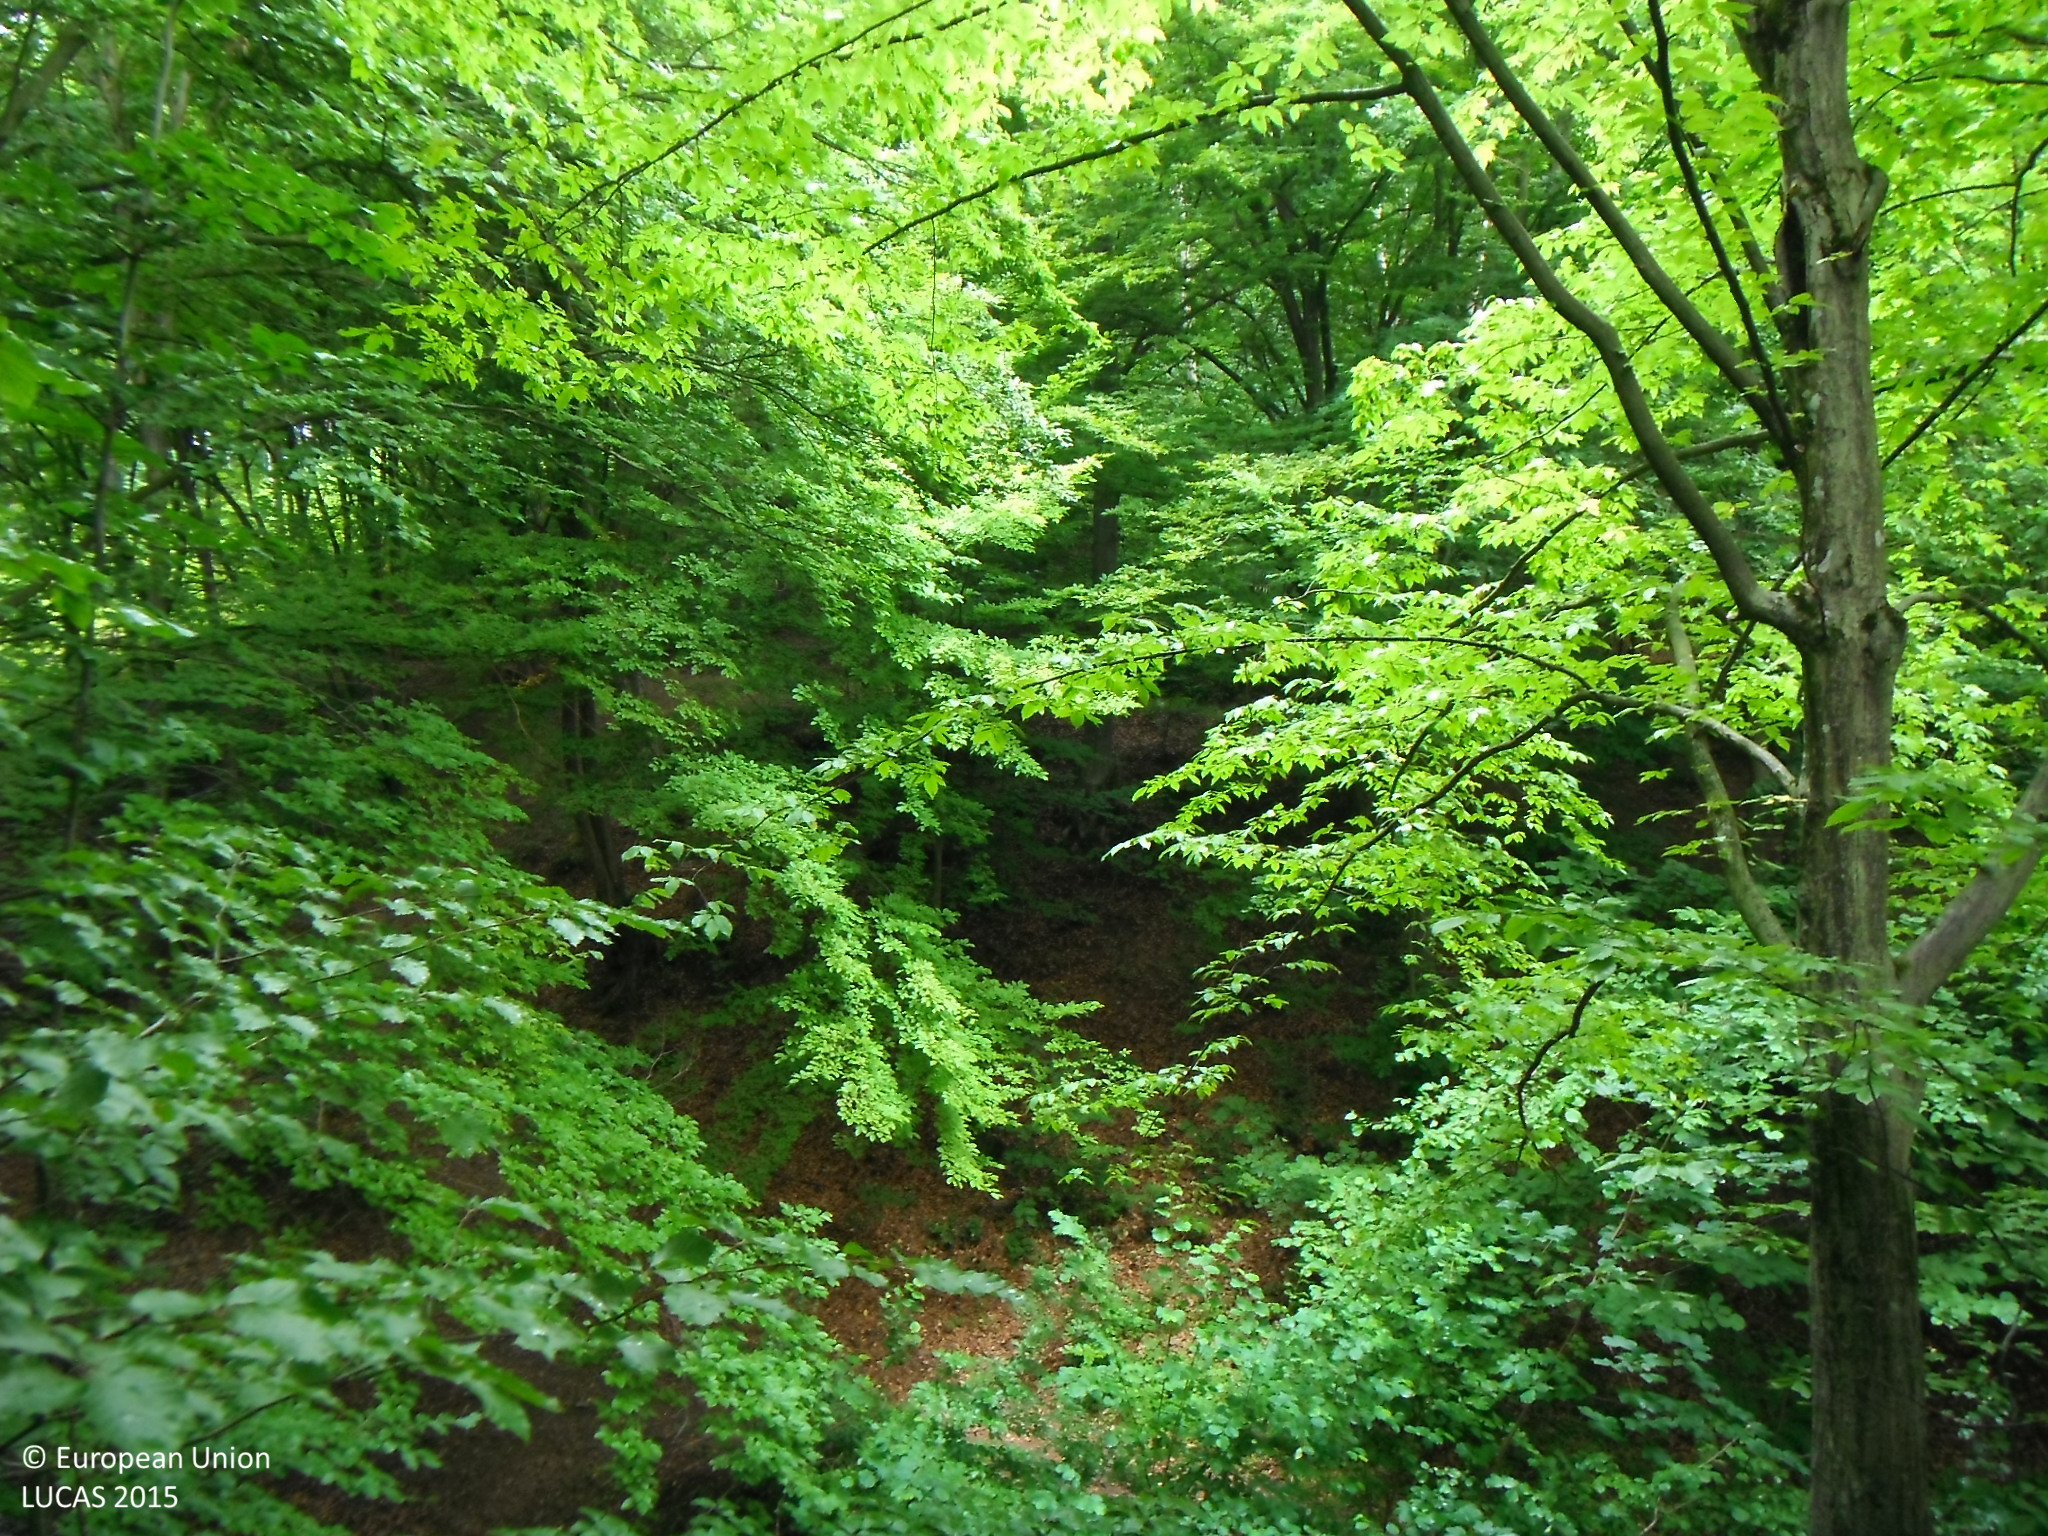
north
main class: Woodland
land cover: Broadleaved woodland
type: beech forest
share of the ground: > 75 %
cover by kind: broadleaved forest trees 100 %
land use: Forestry
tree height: > 5 m
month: July
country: SK
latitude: 49.3515
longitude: 21.2655
